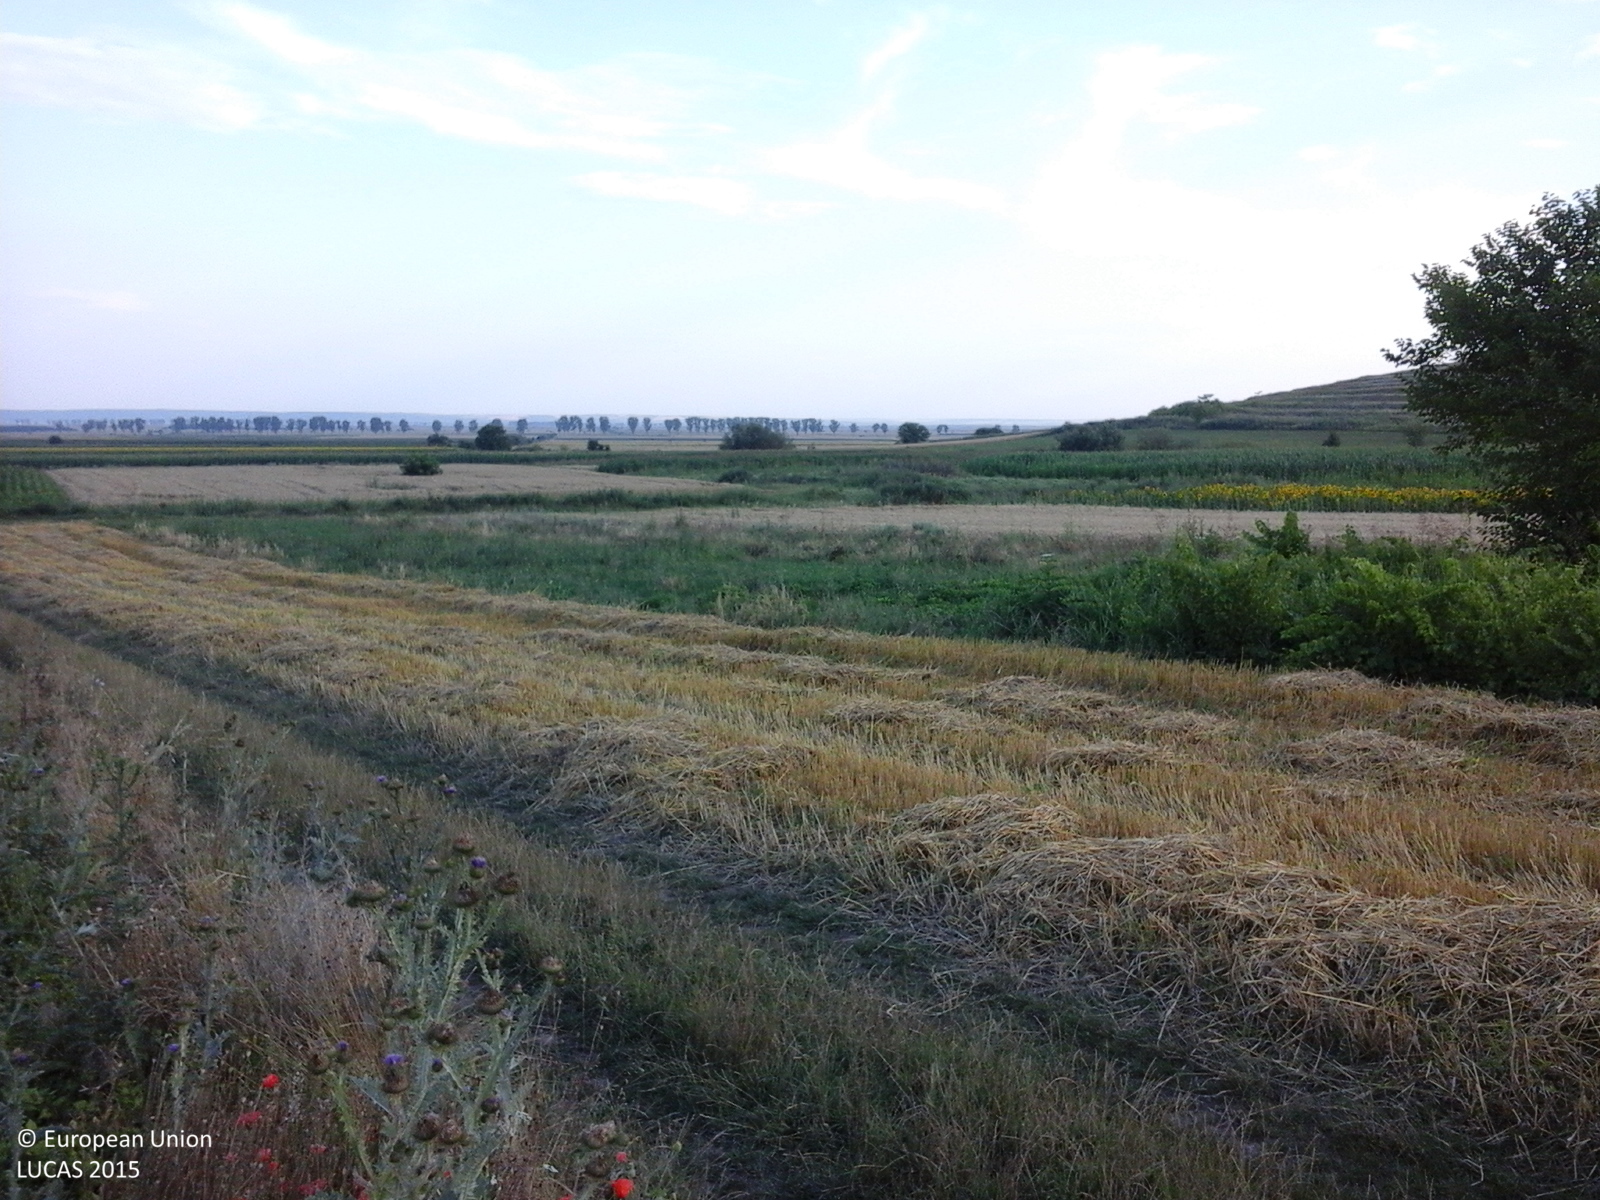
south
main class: Cropland
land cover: Rape and turnip rape
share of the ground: < 10 %
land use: Agriculture (excluding fallow land and kitchen gardens)
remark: Harvested field
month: July
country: RO
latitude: 43.9128
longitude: 25.8463
